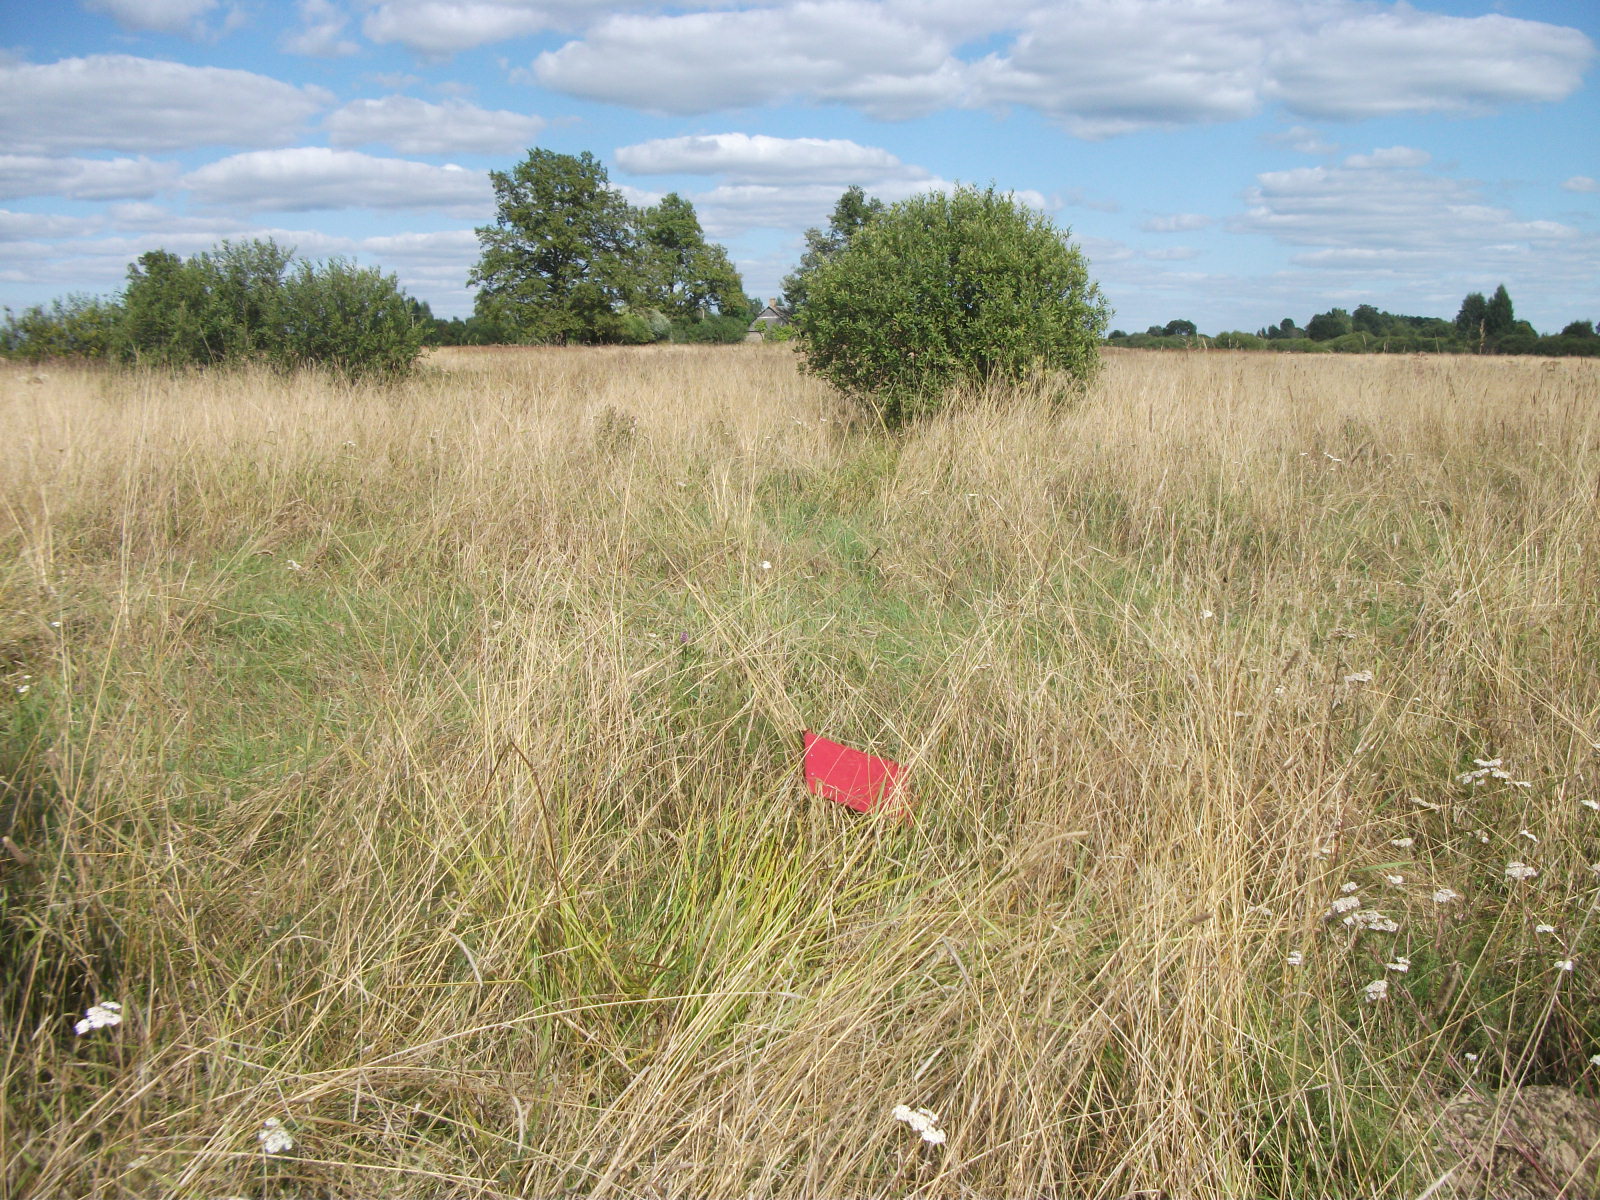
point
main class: Grassland
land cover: Grassland with sparse tree/shrub cover
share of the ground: > 75 %
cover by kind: herbaceous plants 85 %, shrubs 10 %, broadleaved forest trees 5 %
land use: Abandoned areas
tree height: < 5 m
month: August
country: LV
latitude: 56.4095
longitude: 26.4007
